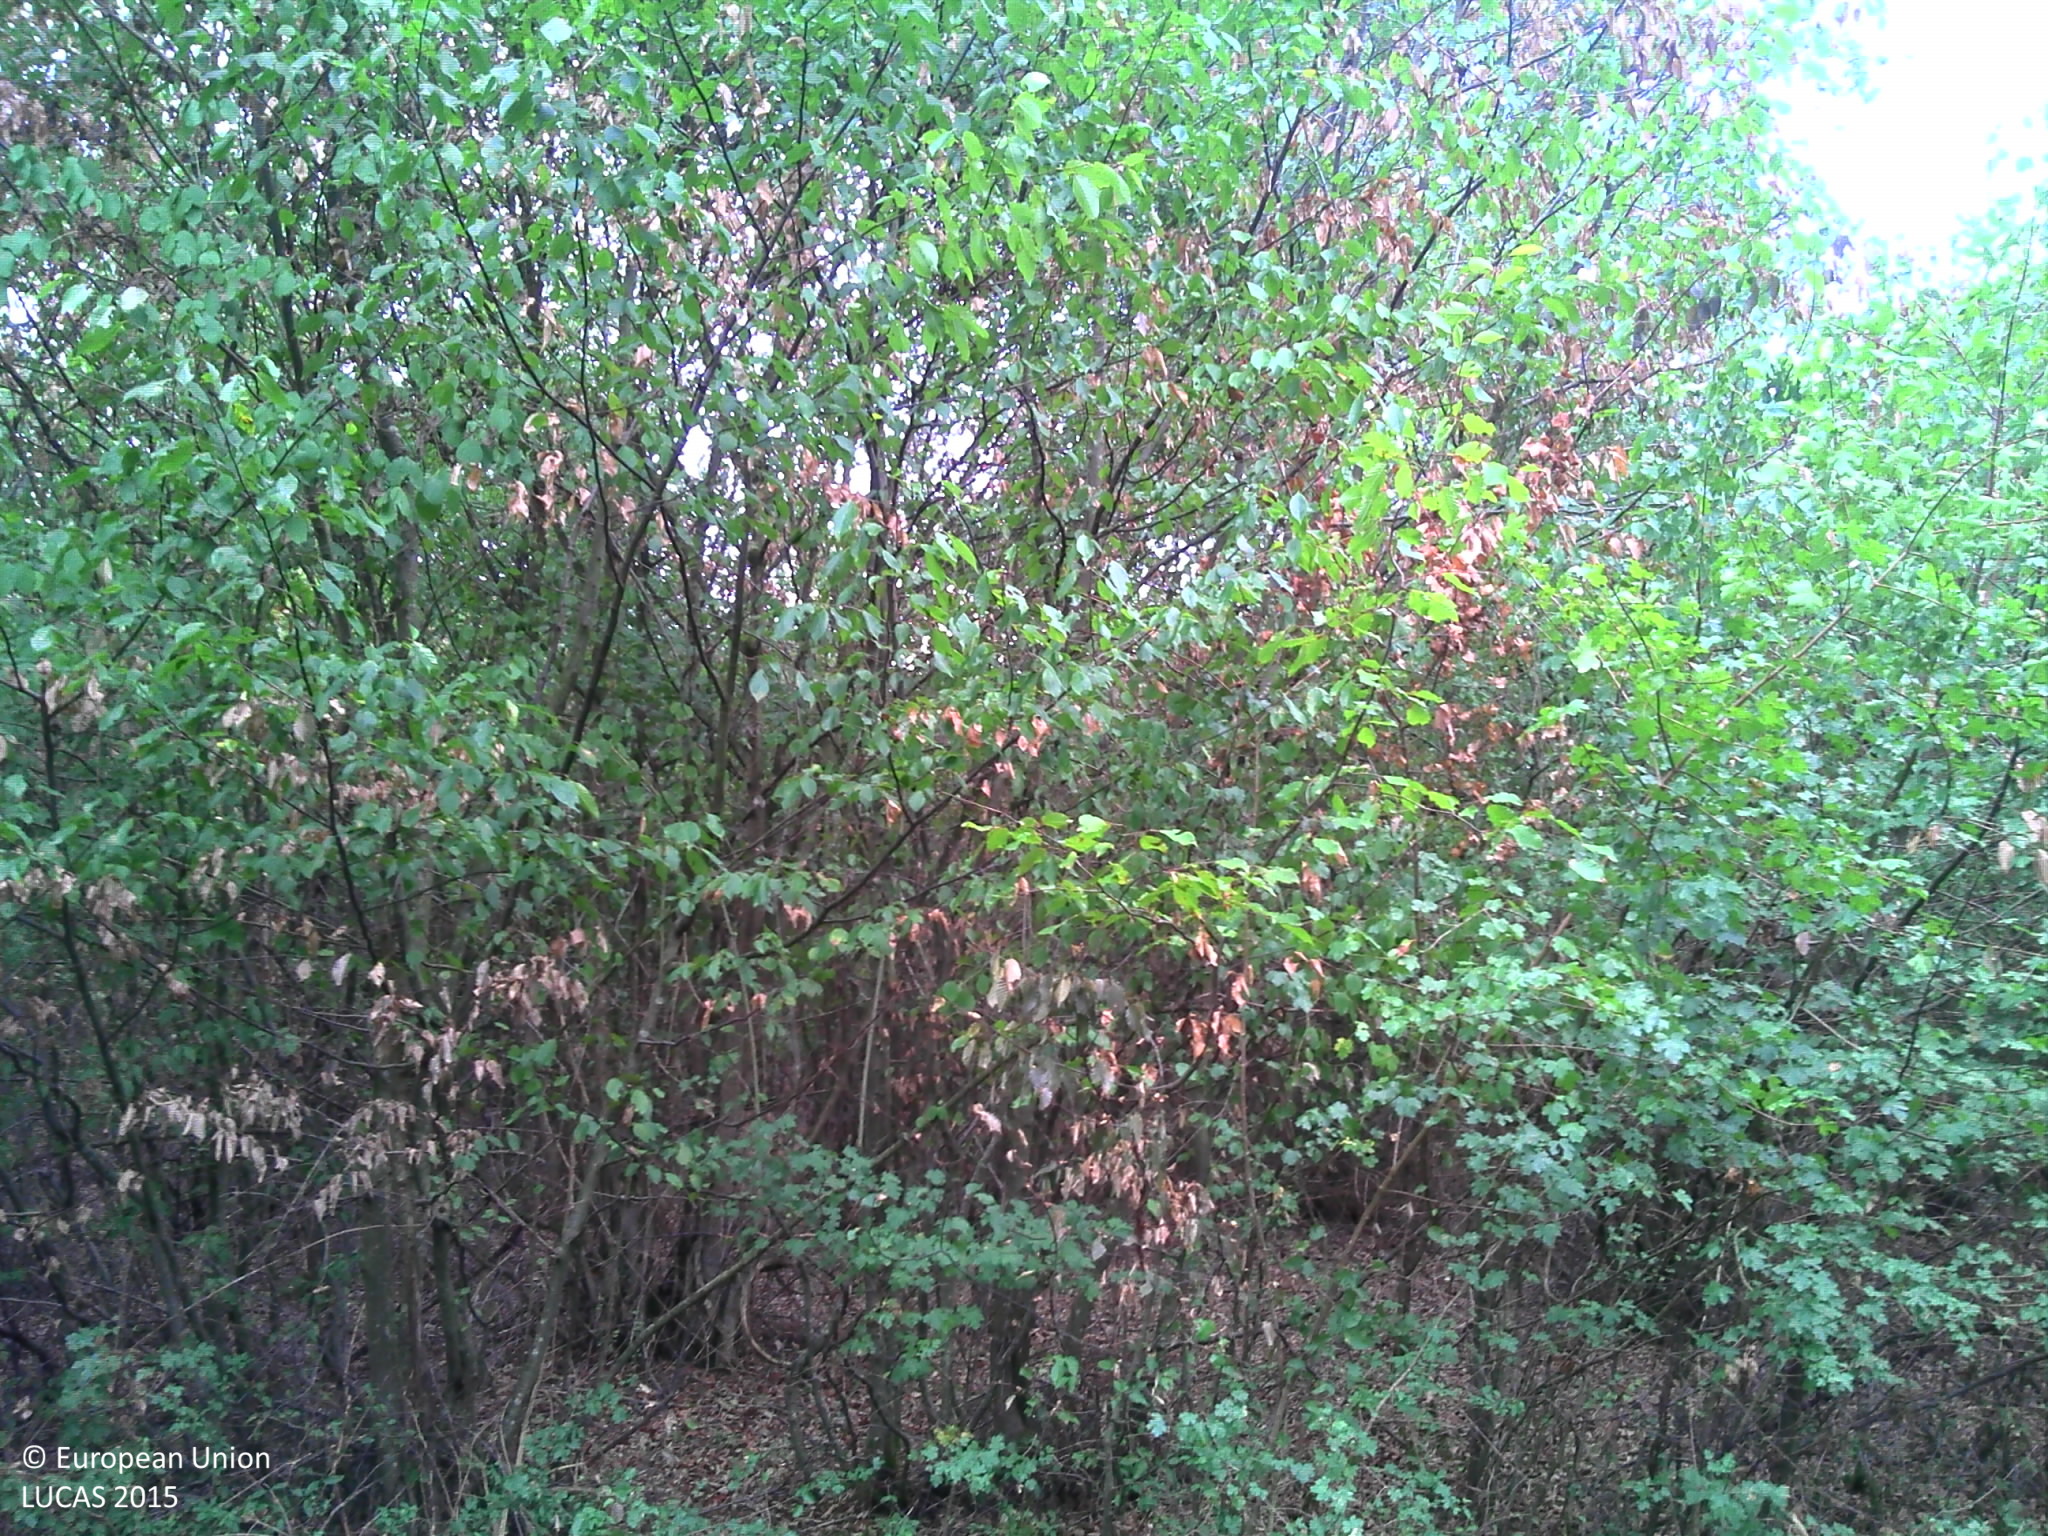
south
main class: Woodland
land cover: Broadleaved woodland
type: mesophytic deciduous forest
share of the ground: > 75 %
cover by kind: broadleaved forest trees 85 %, herbaceous plants 15 %
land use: Semi-natural and natural areas not in use
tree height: > 5 m
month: August
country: FR
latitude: 48.0504
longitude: 7.4656
